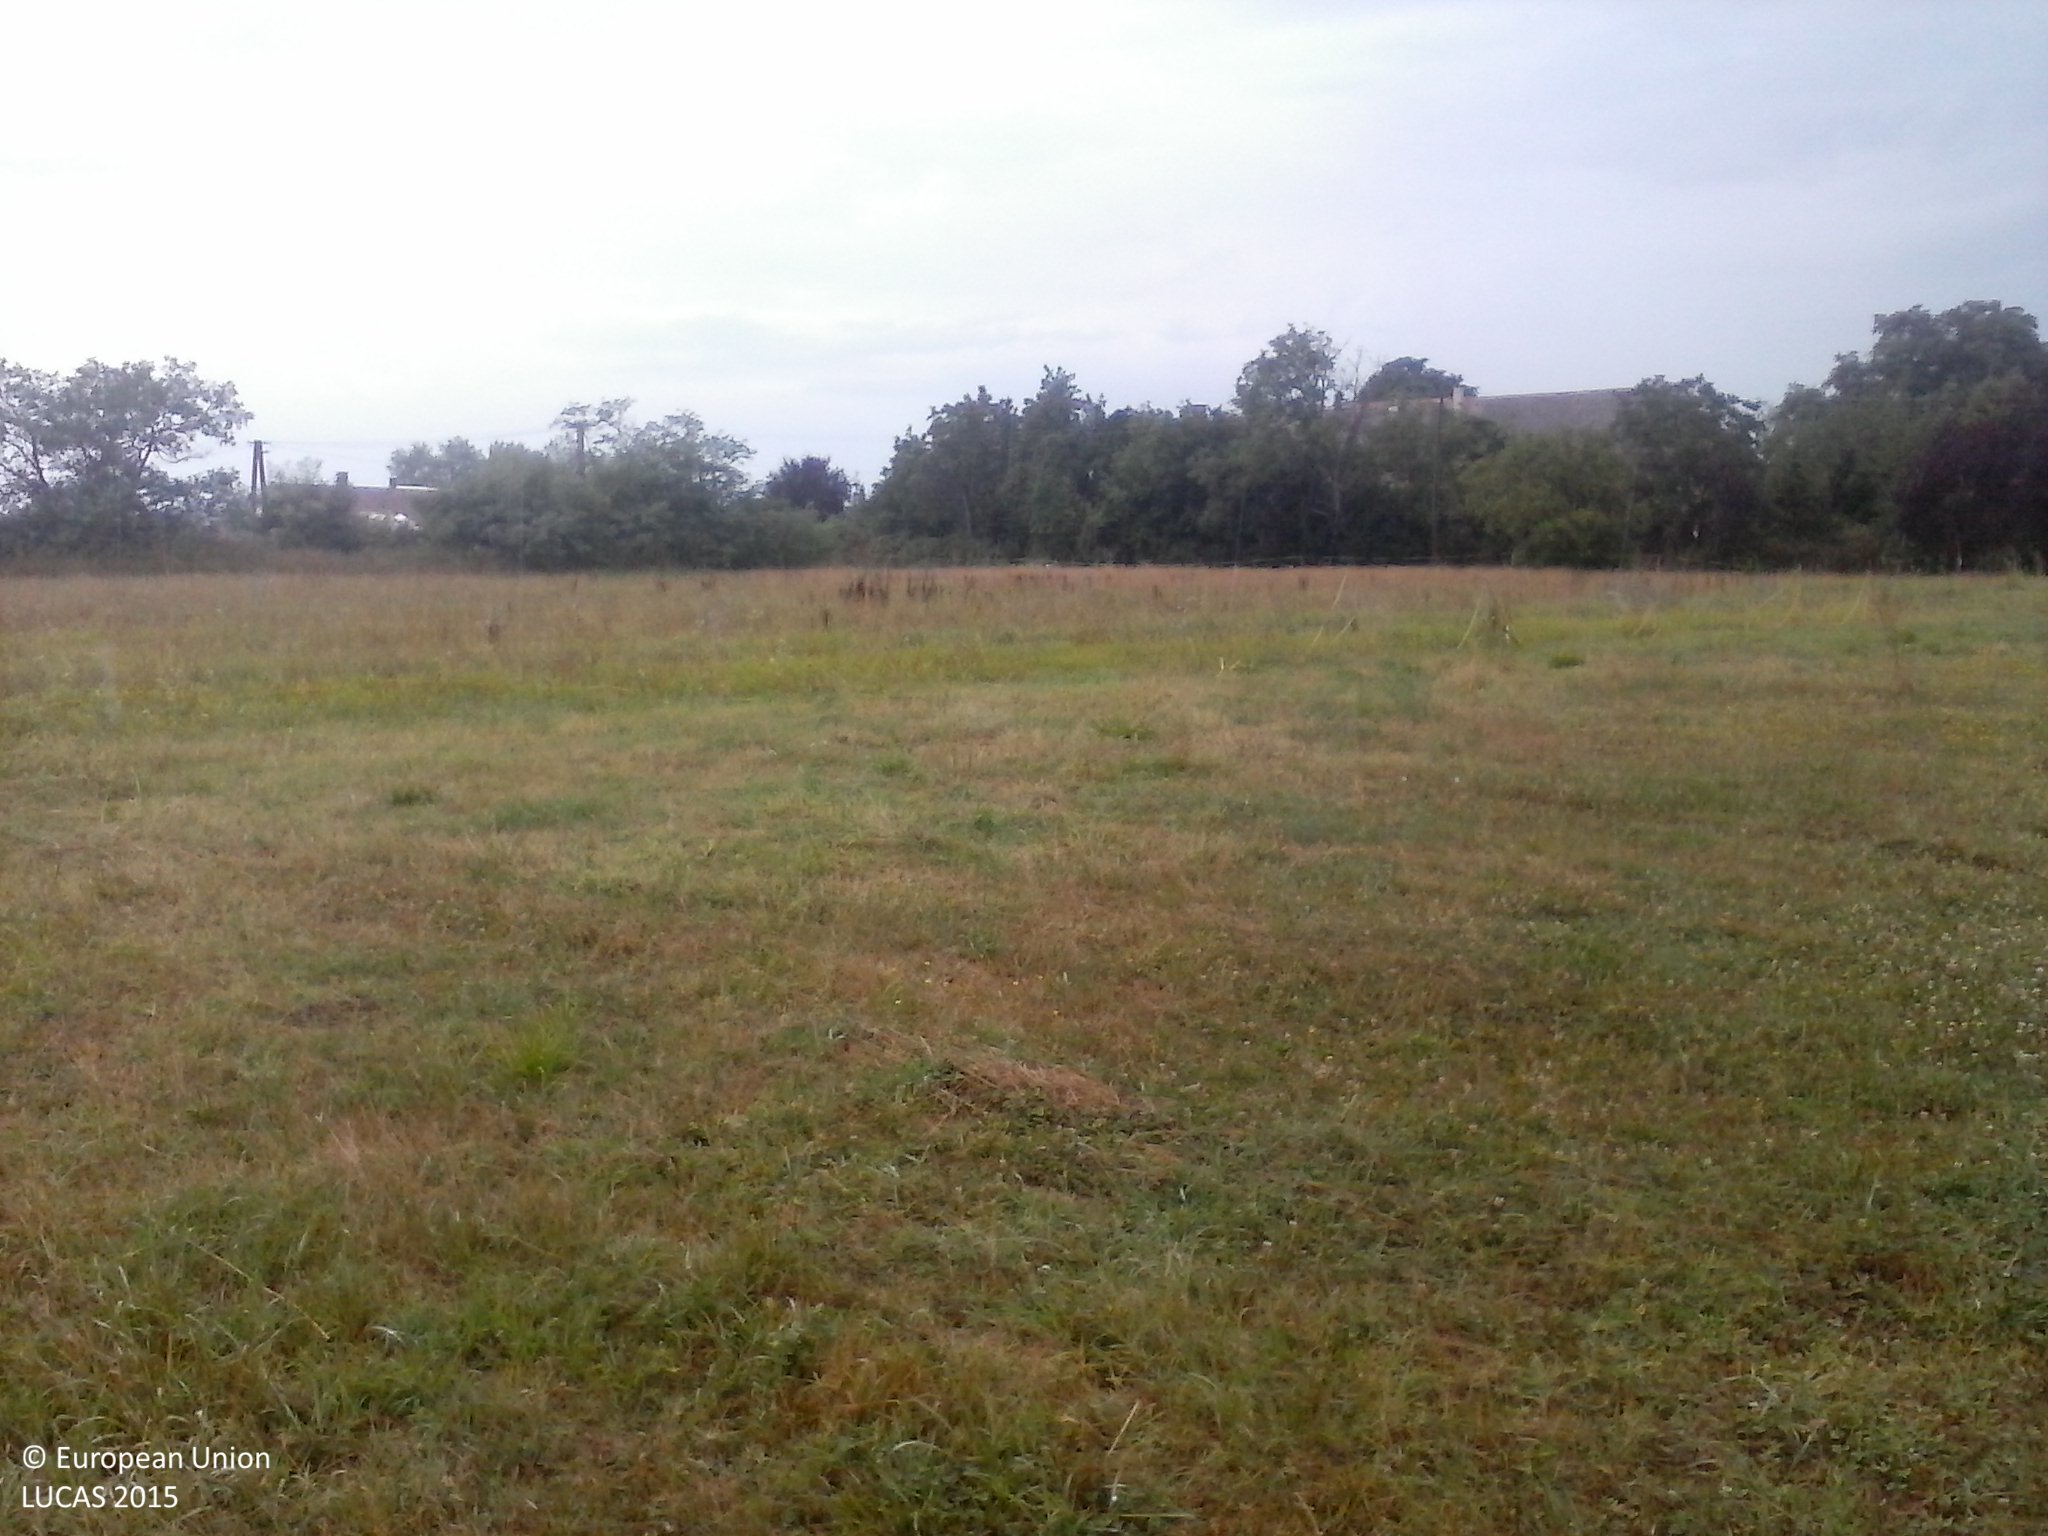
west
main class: Shrubland
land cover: Shrubland with sparse tree cover
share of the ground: > 75 %
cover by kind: shrubs 90 %, broadleaved forest trees 5 %, herbaceous plants 5 %
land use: Agriculture (excluding fallow land and kitchen gardens)
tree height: > 5 m
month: July
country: HU
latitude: 46.0359
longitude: 17.7181
